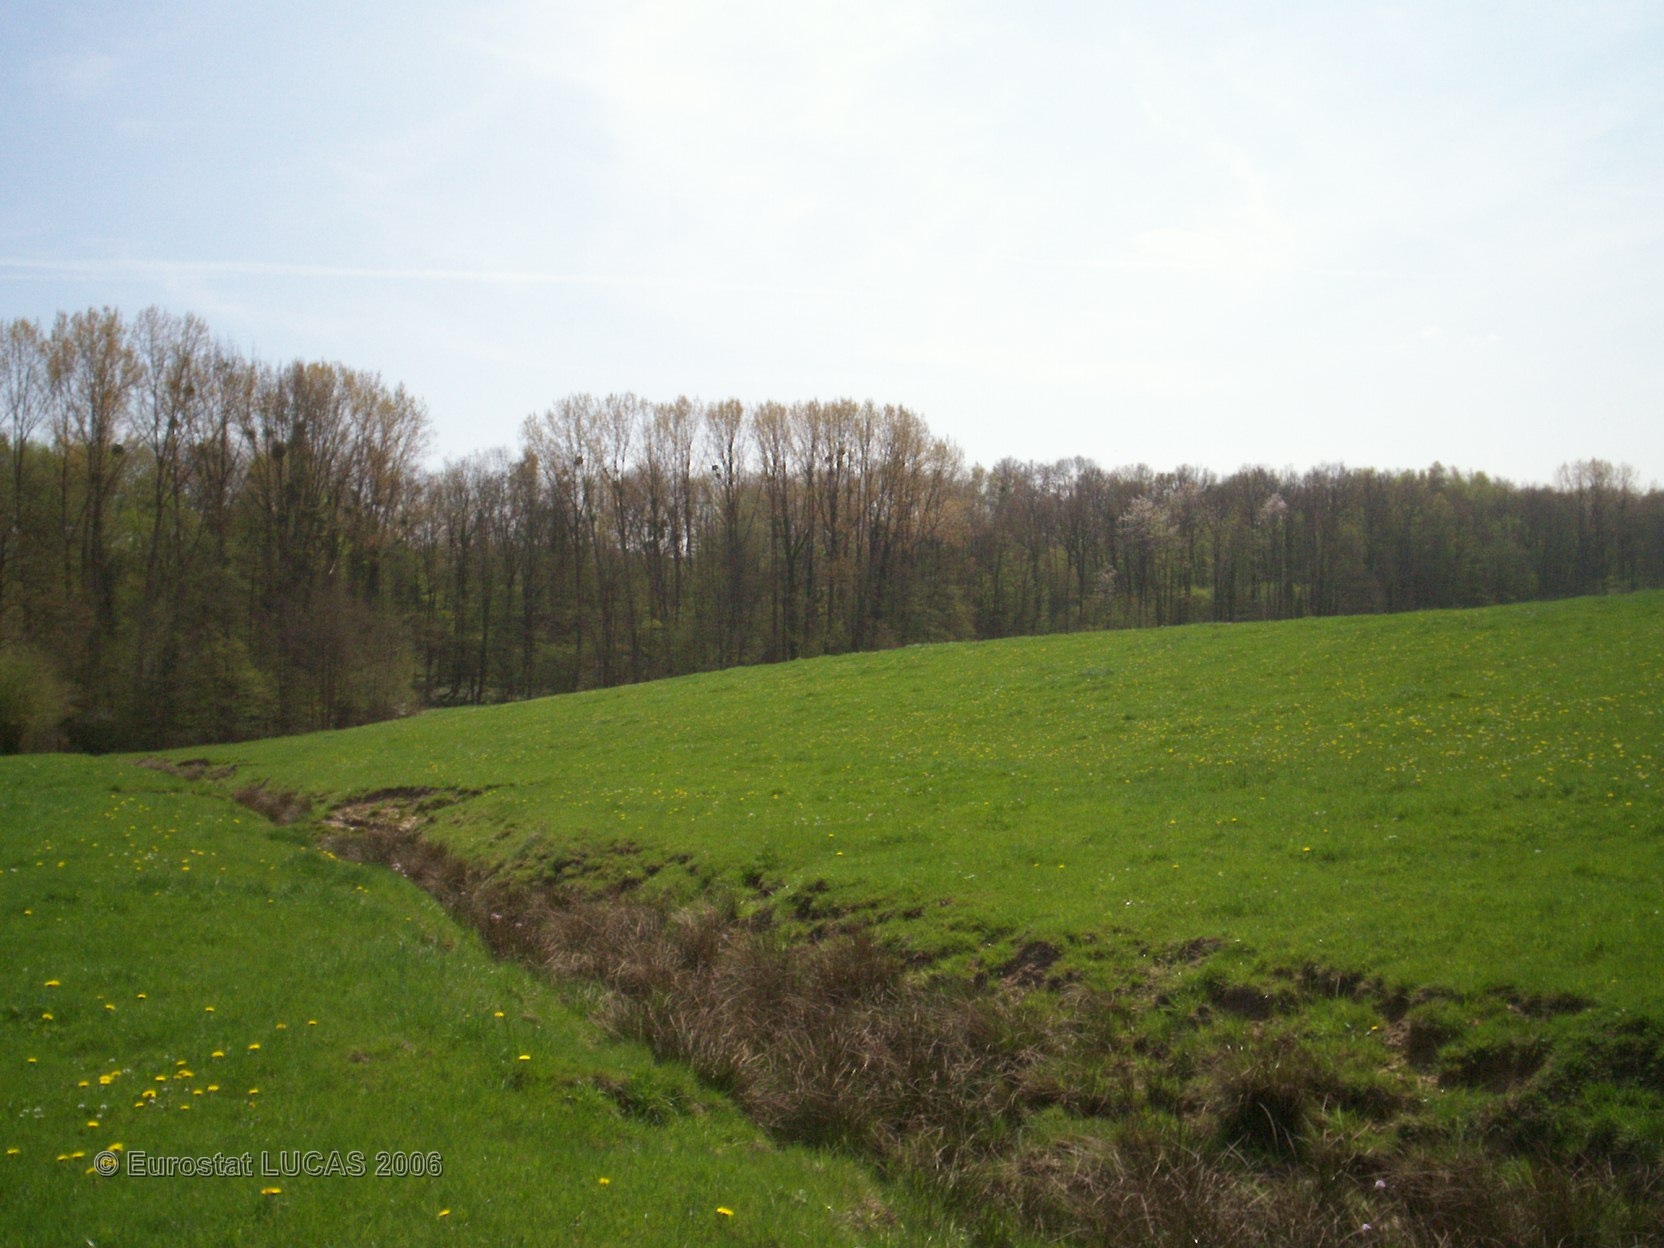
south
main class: Grassland
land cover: Grassland without tree/shrub cover
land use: Agriculture (excluding fallow land and kitchen gardens)
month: April
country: FR
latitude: 49.7183
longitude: 4.3228
